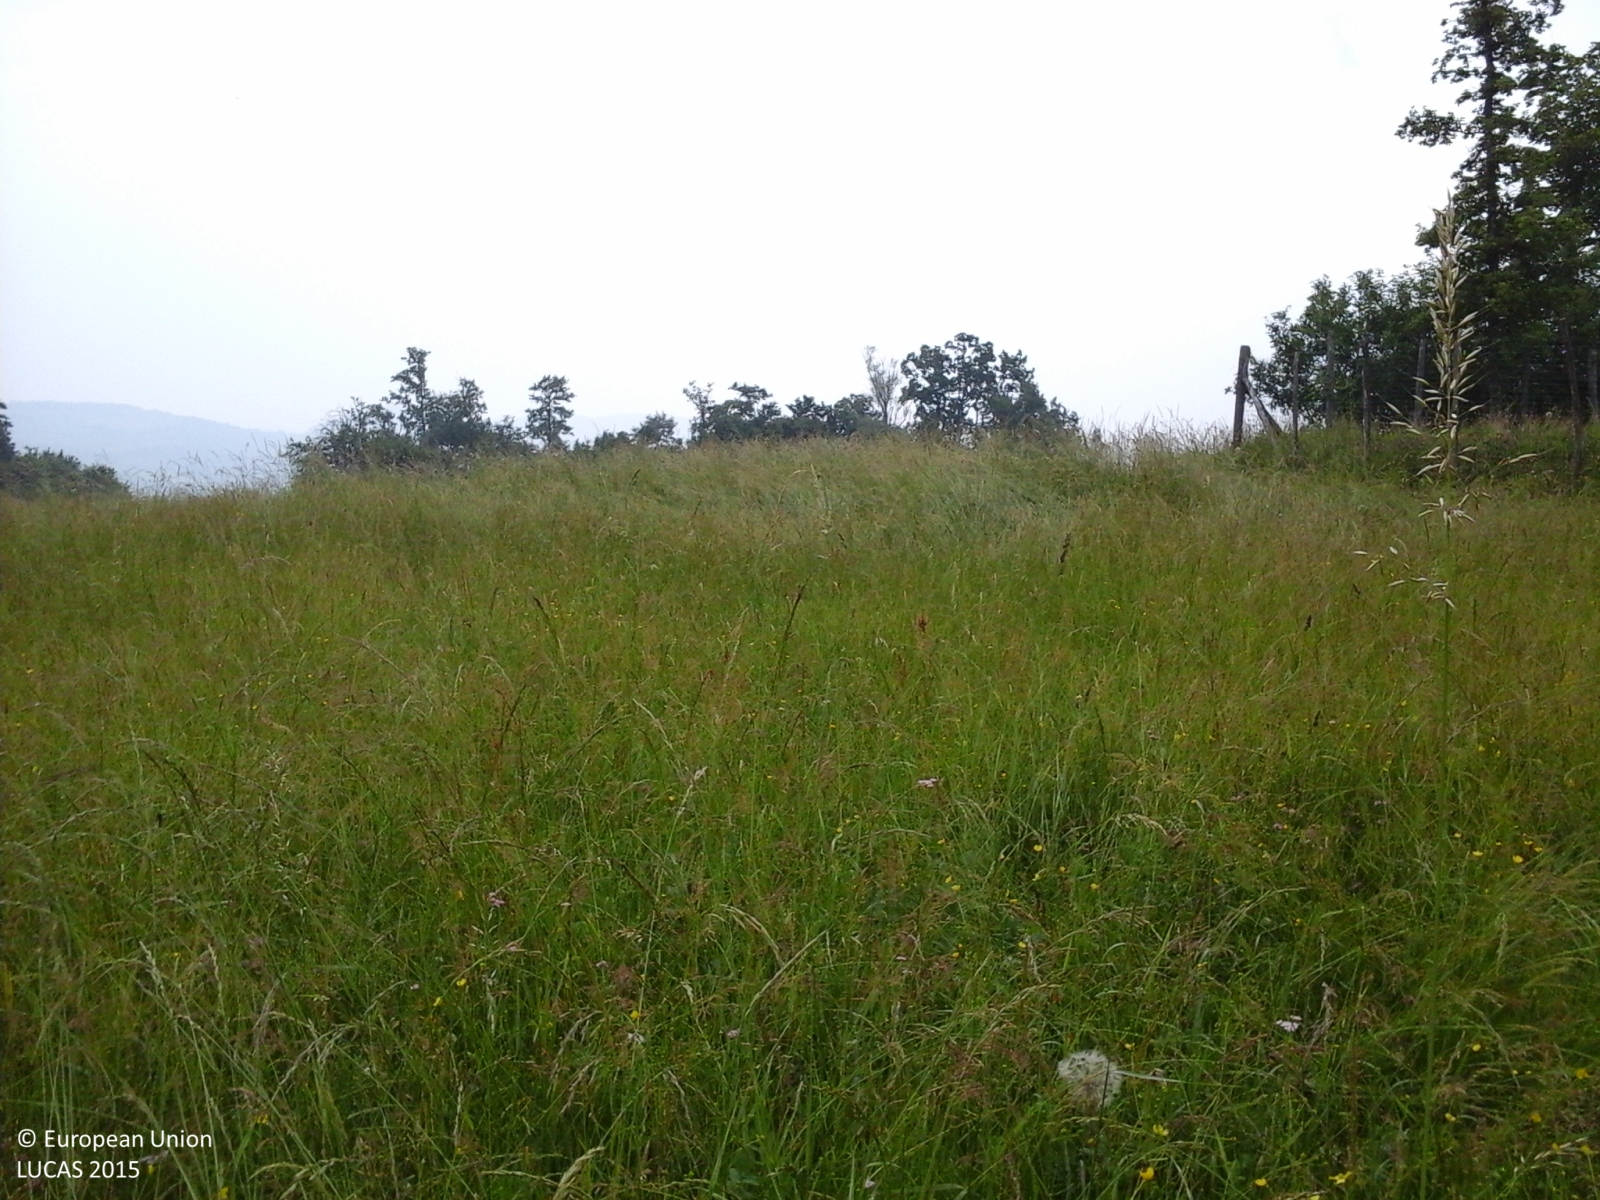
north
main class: Grassland
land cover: Grassland without tree/shrub cover
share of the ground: > 75 %
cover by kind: herbaceous plants 100 %
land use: Agriculture (excluding fallow land and kitchen gardens)
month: June
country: IT
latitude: 44.7468
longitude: 9.6849
